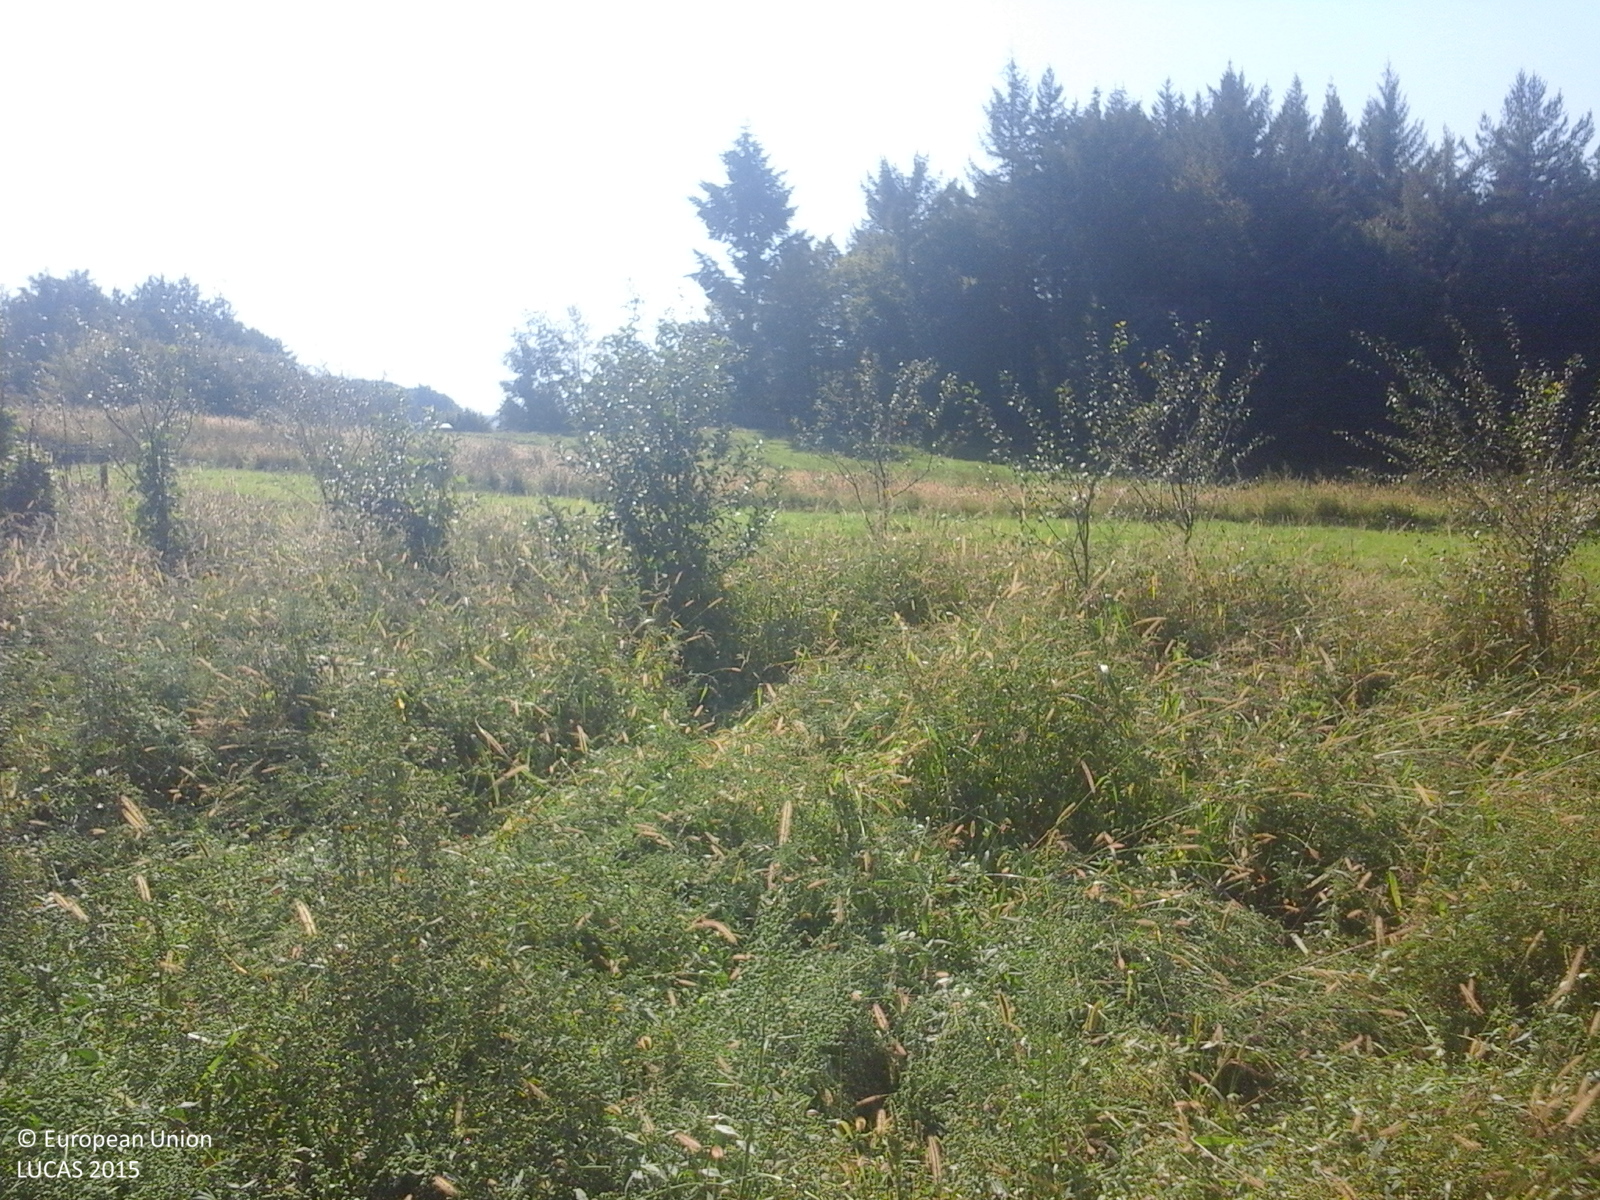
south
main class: Grassland
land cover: Grassland without tree/shrub cover
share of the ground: > 75 %
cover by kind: herbaceous plants 100 %
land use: Agriculture (excluding fallow land and kitchen gardens)
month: September
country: RO
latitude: 47.0829
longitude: 22.7159
